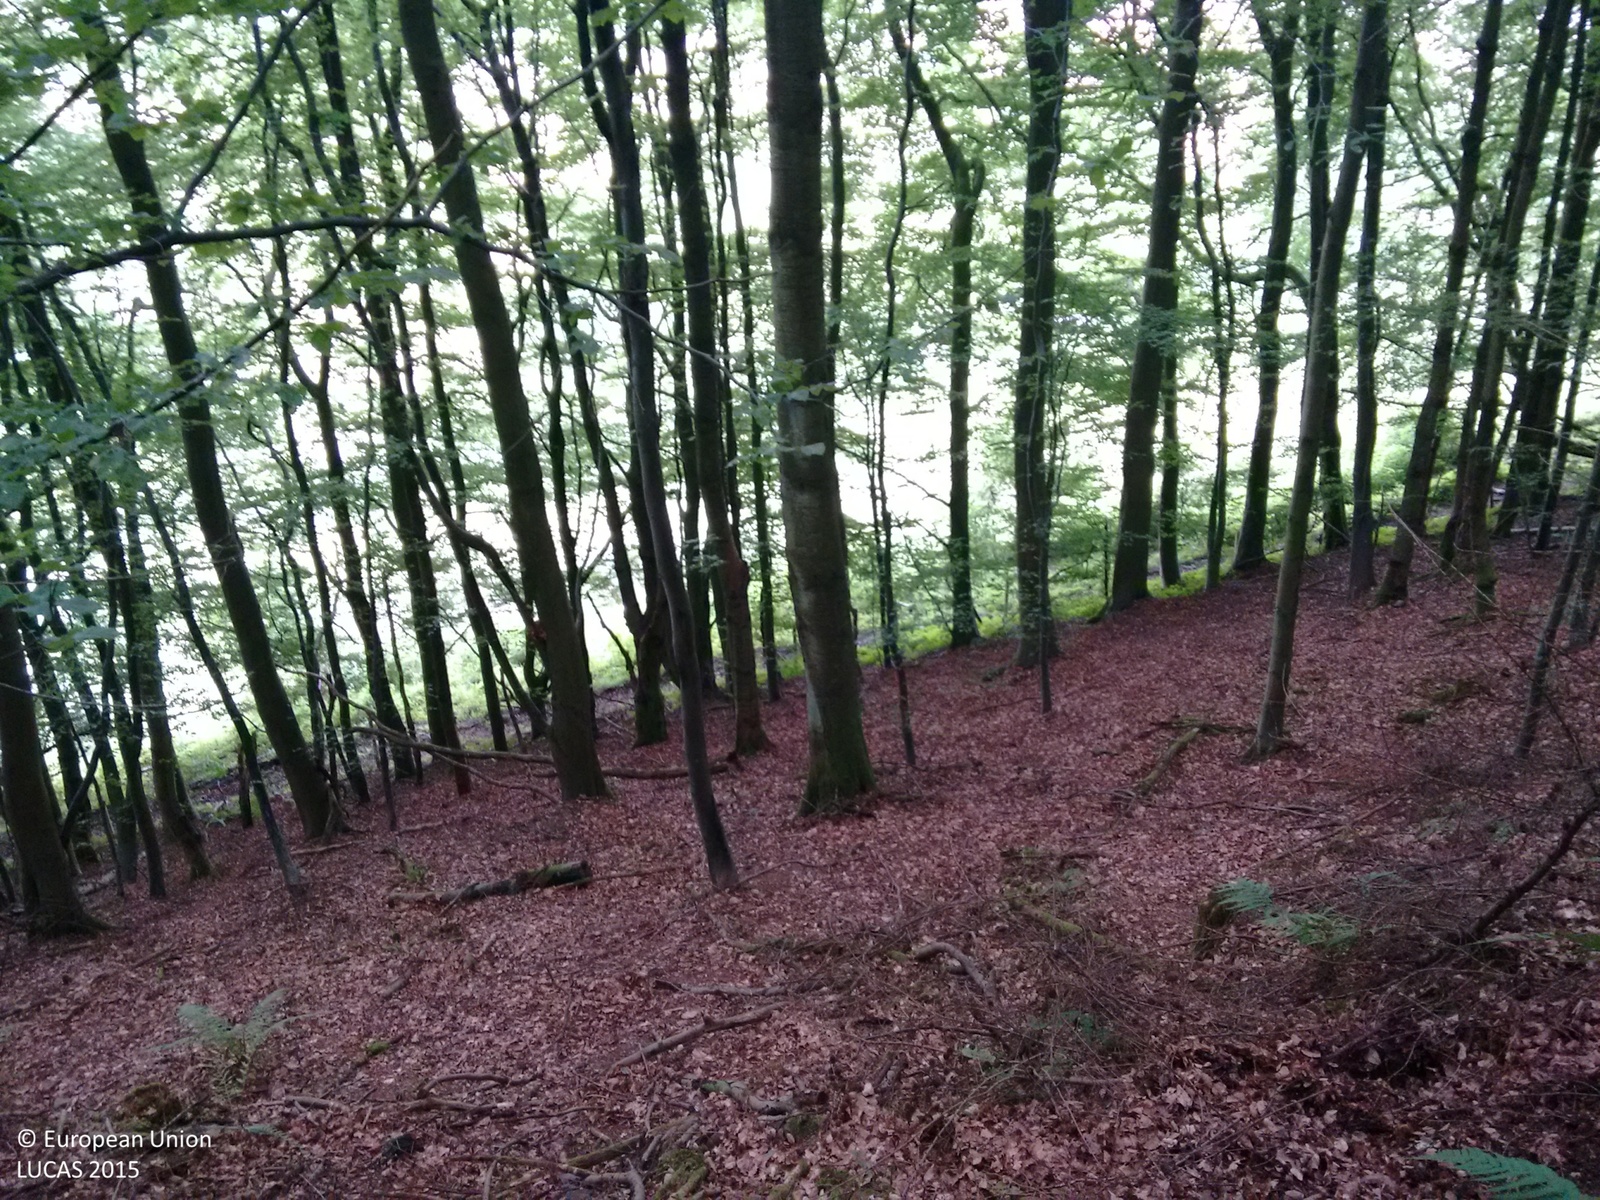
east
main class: Woodland
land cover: Broadleaved woodland
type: mesophytic deciduous forest
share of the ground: > 75 %
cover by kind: broadleaved forest trees 100 %
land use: Semi-natural and natural areas not in use
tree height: > 5 m
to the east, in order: Broadleaved woodland; Fences; Grassland without tree/shrub cover; Fences; Single bushes/trees; Managed hedges; Grass margins; Paved roads, cycling and walking lanes; Grass margins; Managed hedges; Fences; Spontaneously vegetated surfaces; Fences; Grassland without tree/shrub cover; Lines of trees; Fences; Other bare soil
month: July
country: GB
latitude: 55.0338
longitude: -3.6487
